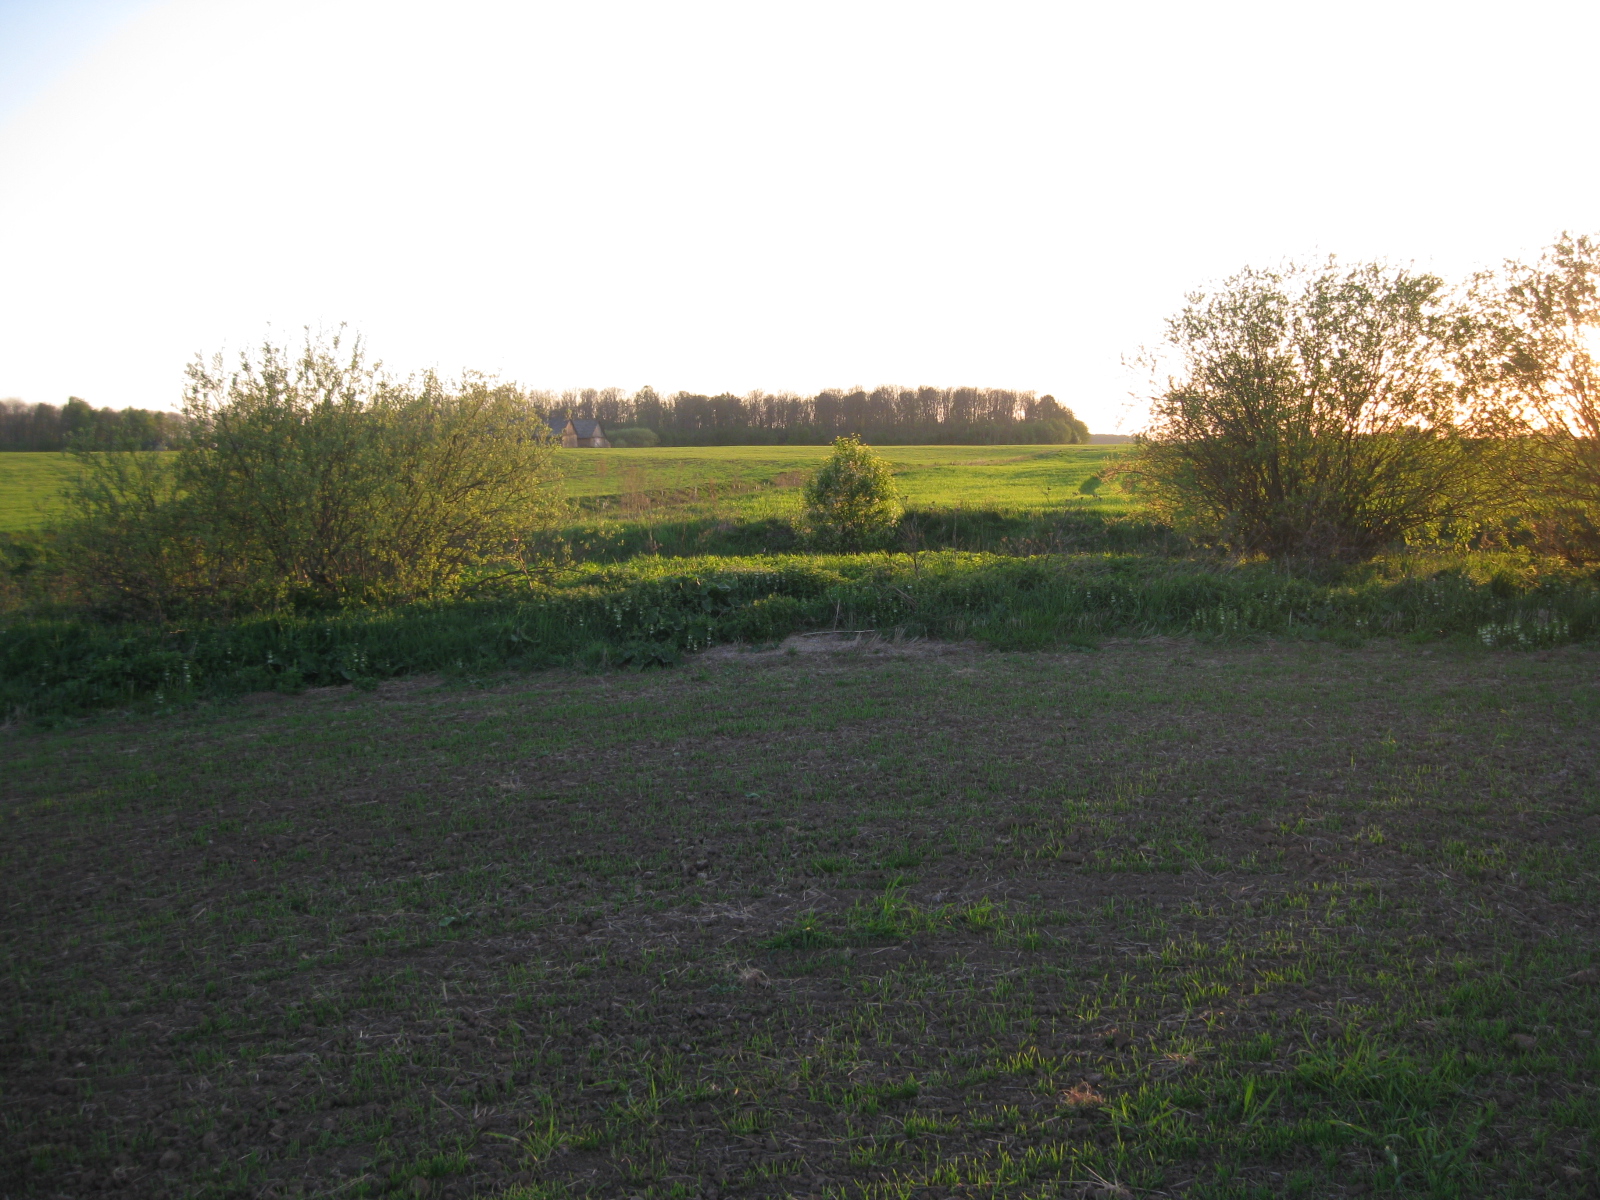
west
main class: Cropland
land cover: Common wheat
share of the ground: < 10 %
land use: Agriculture (excluding fallow land and kitchen gardens)
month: May
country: LT
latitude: 56.1168
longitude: 24.4263
